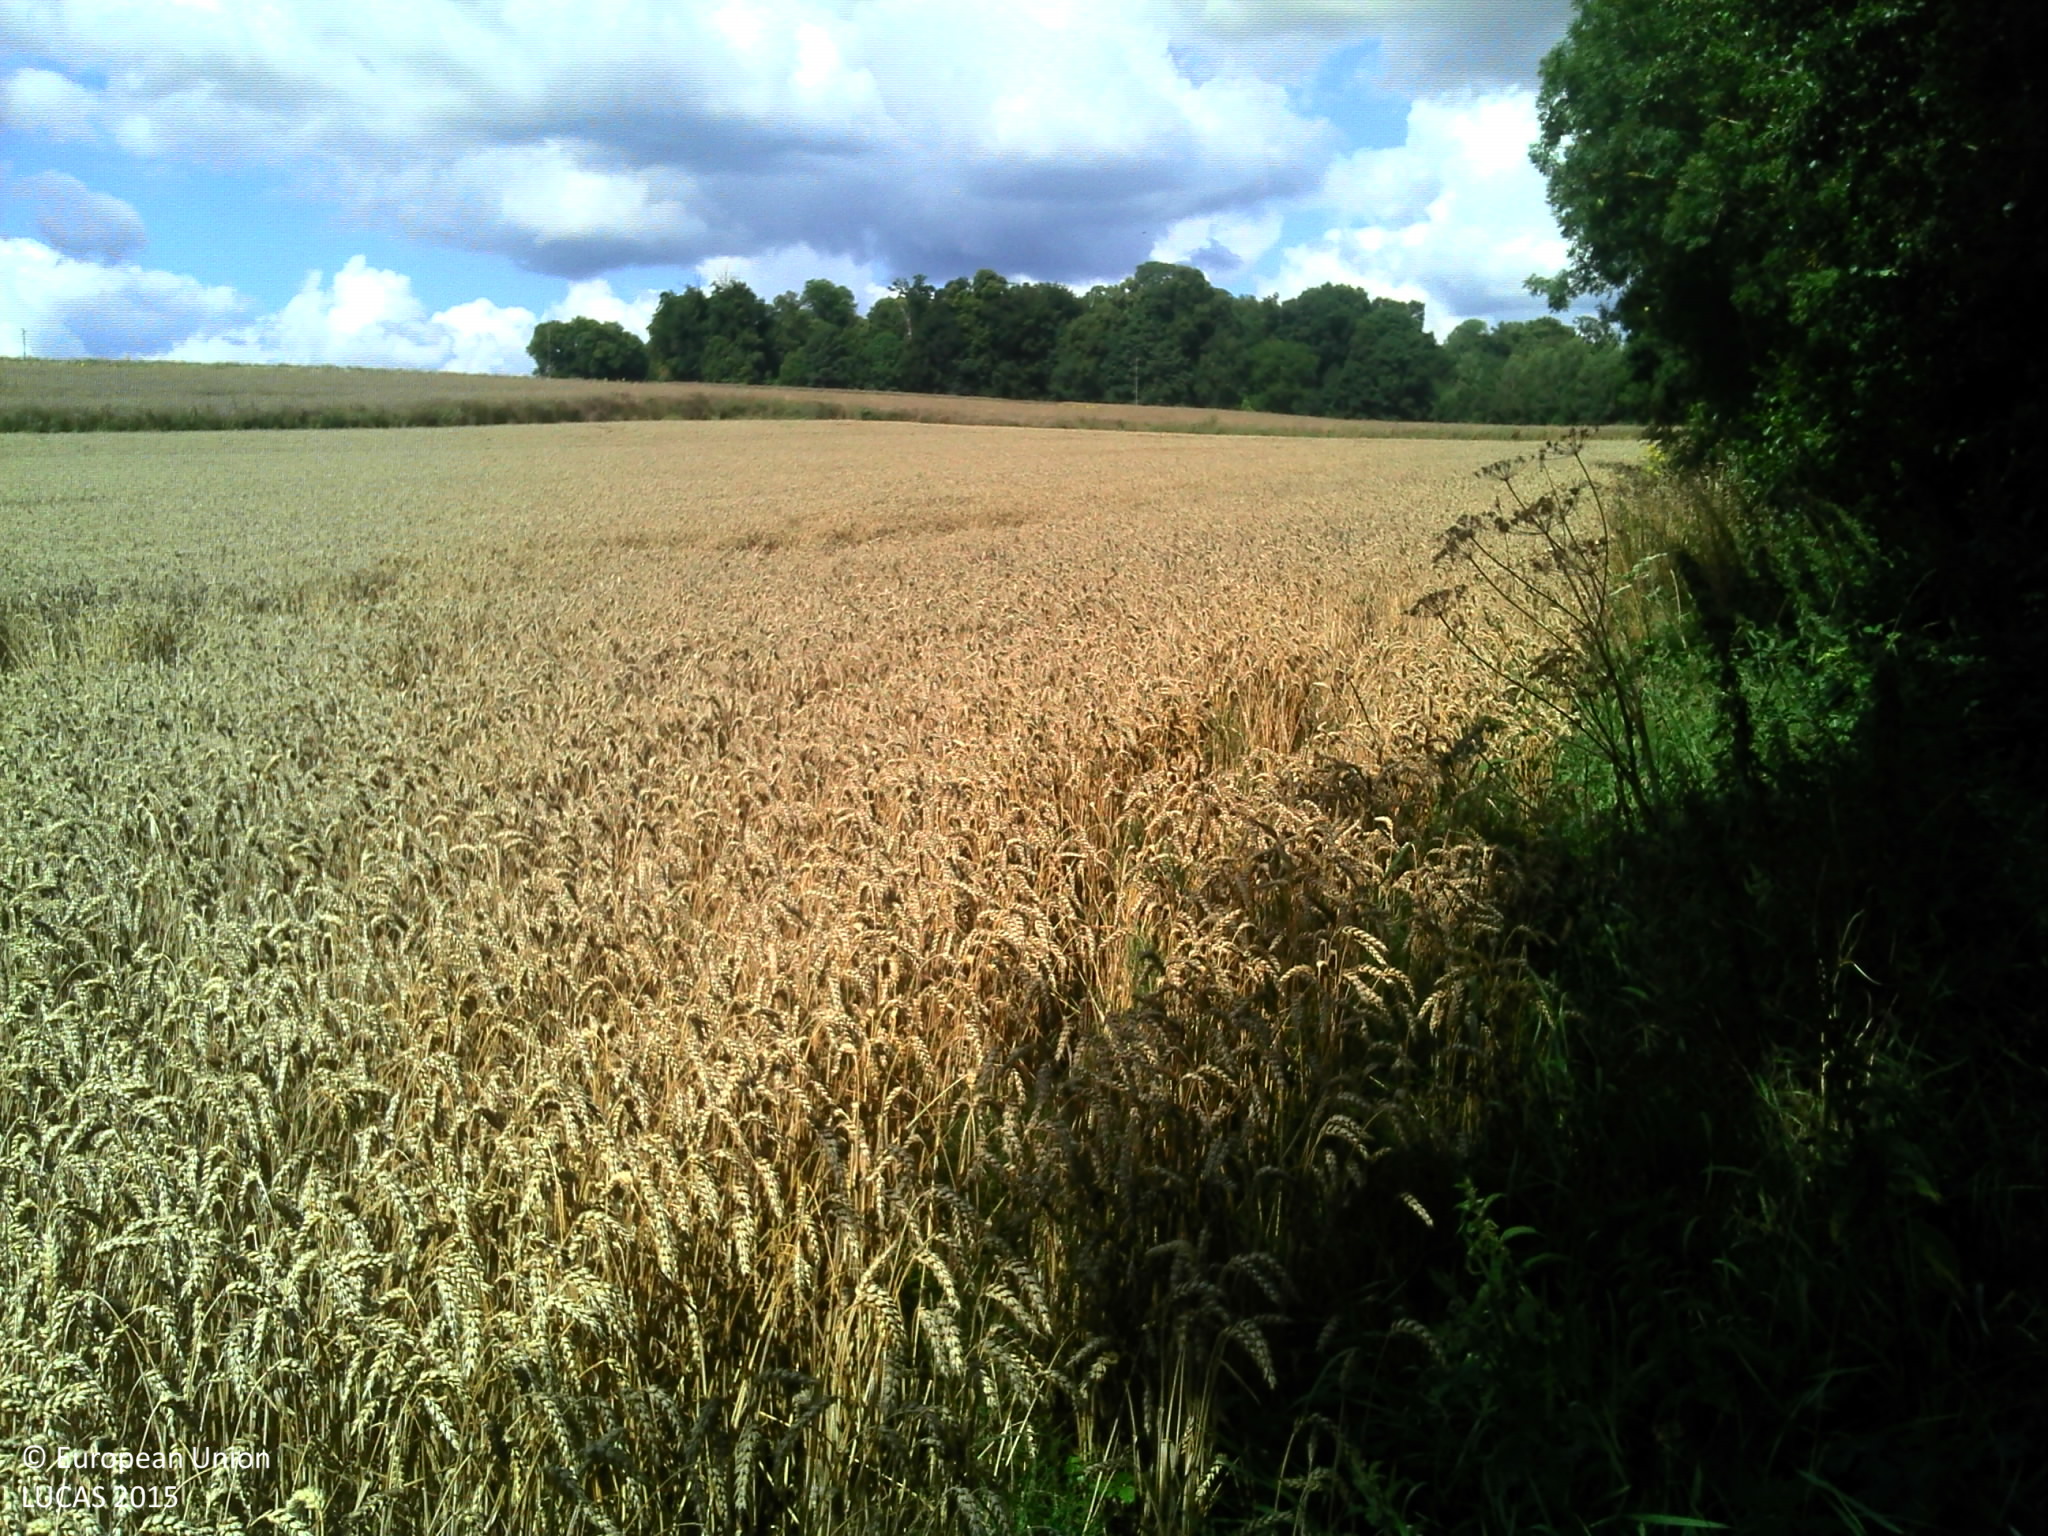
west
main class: Woodland
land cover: Broadleaved woodland
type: mesophytic deciduous forest
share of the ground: > 75 %
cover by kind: broadleaved forest trees 90 %, herbaceous plants 10 %
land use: Semi-natural and natural areas not in use
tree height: < 5 m
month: July
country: FR
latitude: 48.9125
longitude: -0.1705
